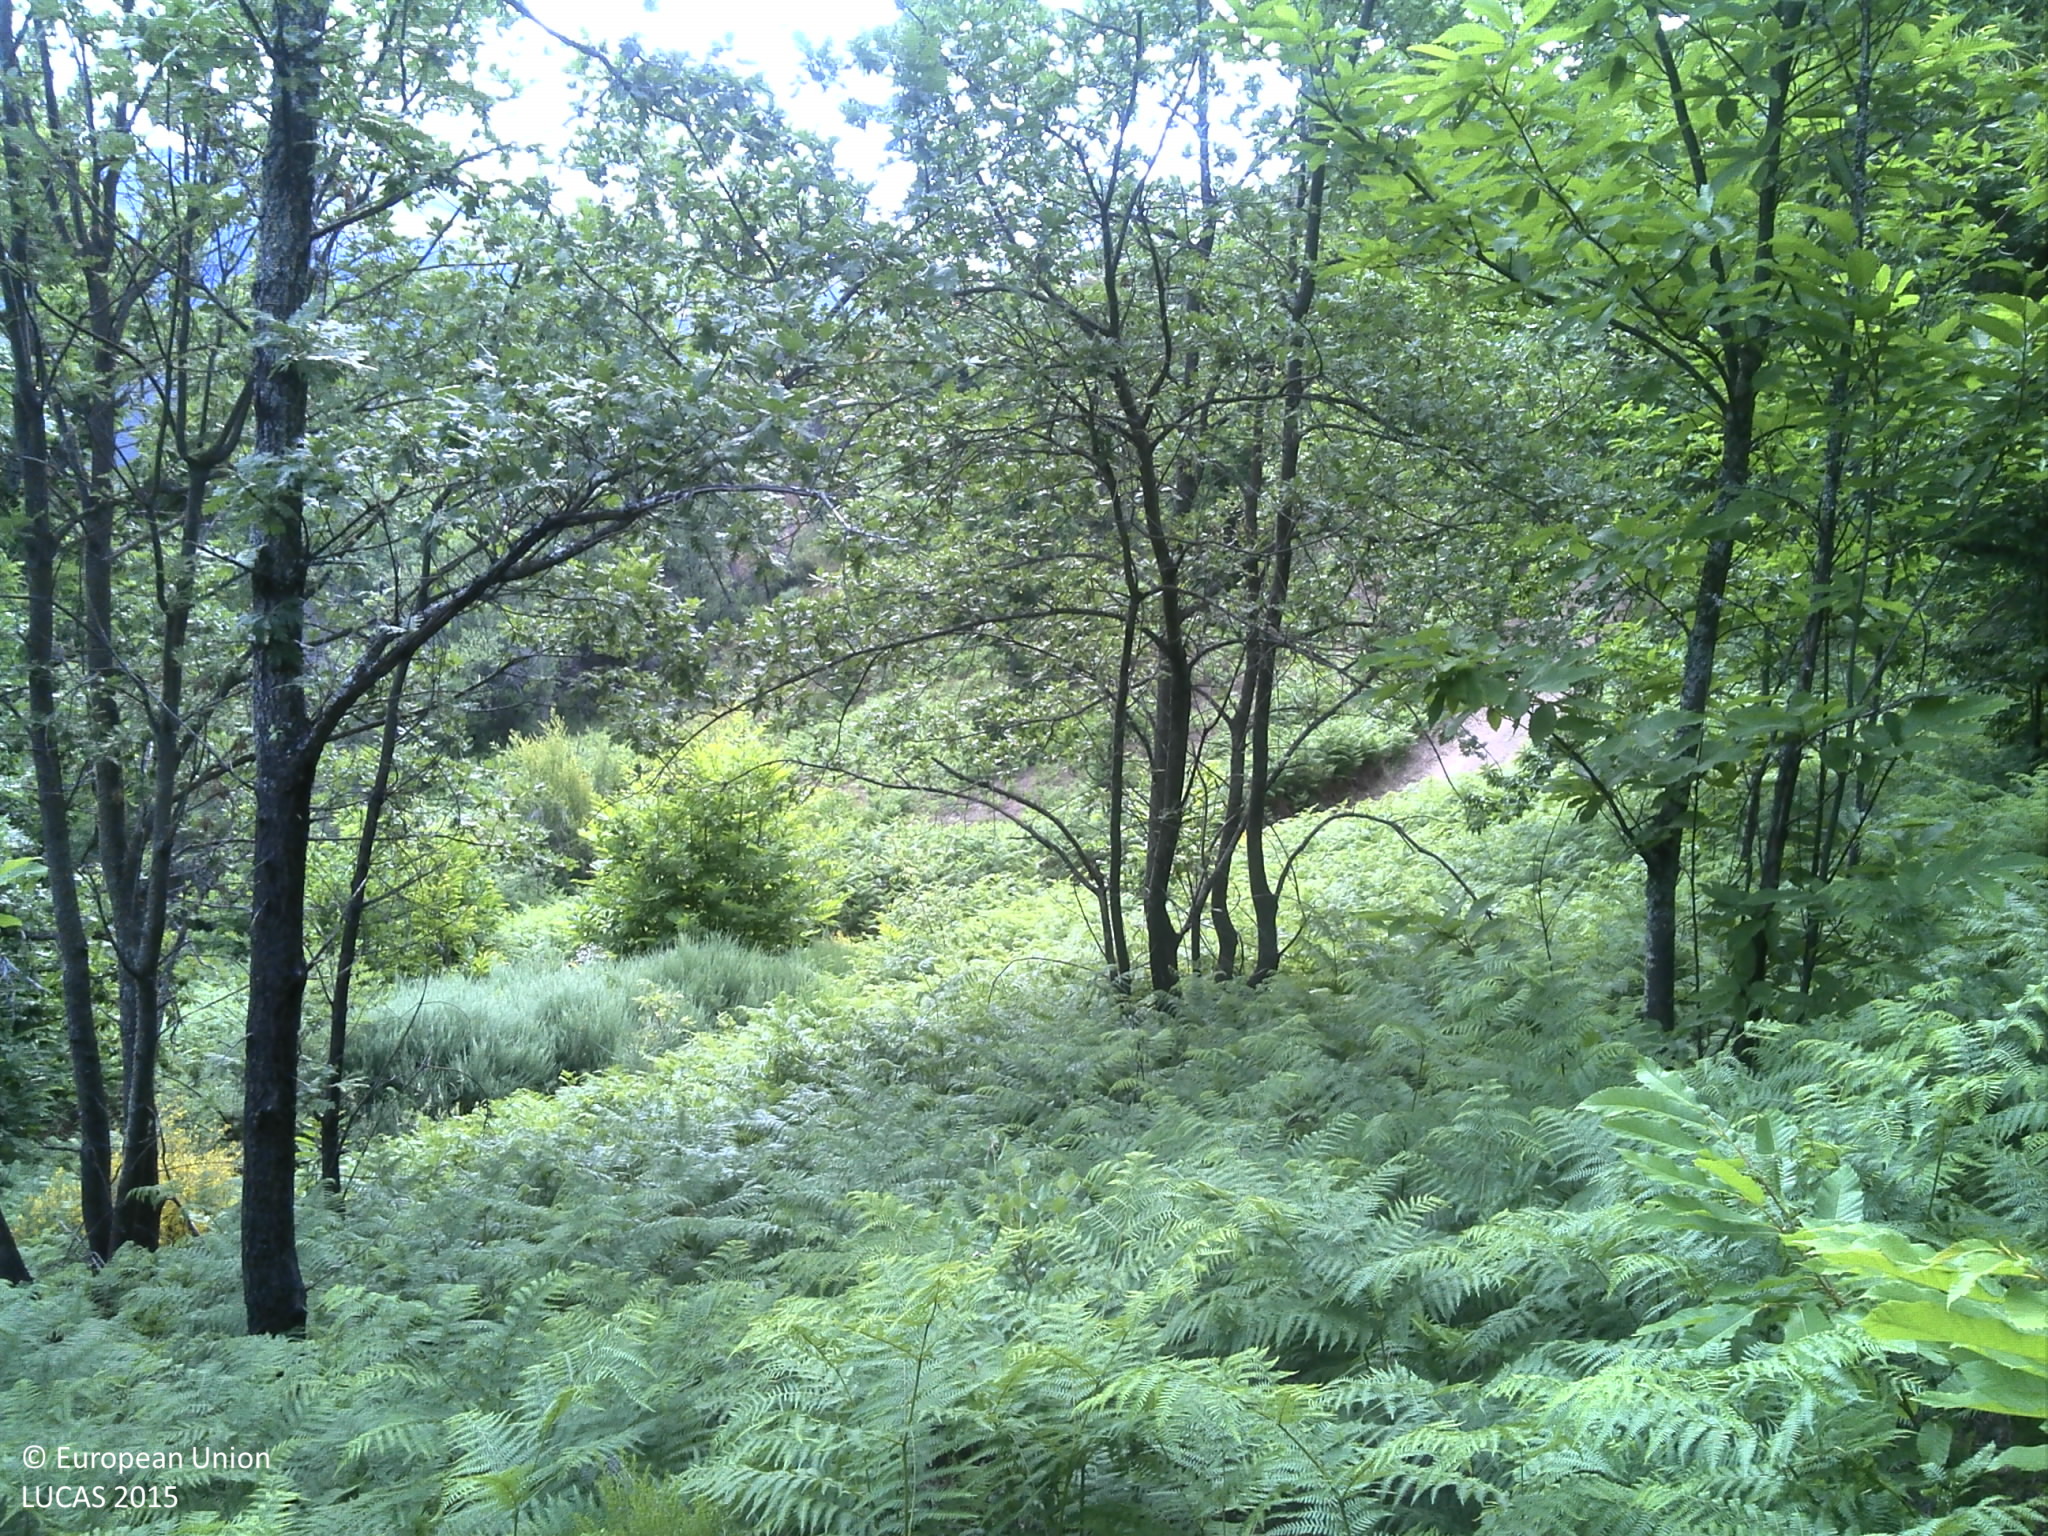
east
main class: Woodland
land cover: Broadleaved woodland
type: thermophilous deciduous forest
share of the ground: 25 - 50 %
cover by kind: shrubs 70 %, broadleaved forest trees 30 %
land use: Forestry
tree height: > 5 m
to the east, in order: Broadleaved woodland; Shrubland without tree cover; Broadleaved woodland; Tracks; Shrubland with sparse tree cover; Broadleaved woodland; Shrubland with sparse tree cover; Nuts trees; Tracks; Nuts trees
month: June
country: PT
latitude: 41.8399
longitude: -6.6209
